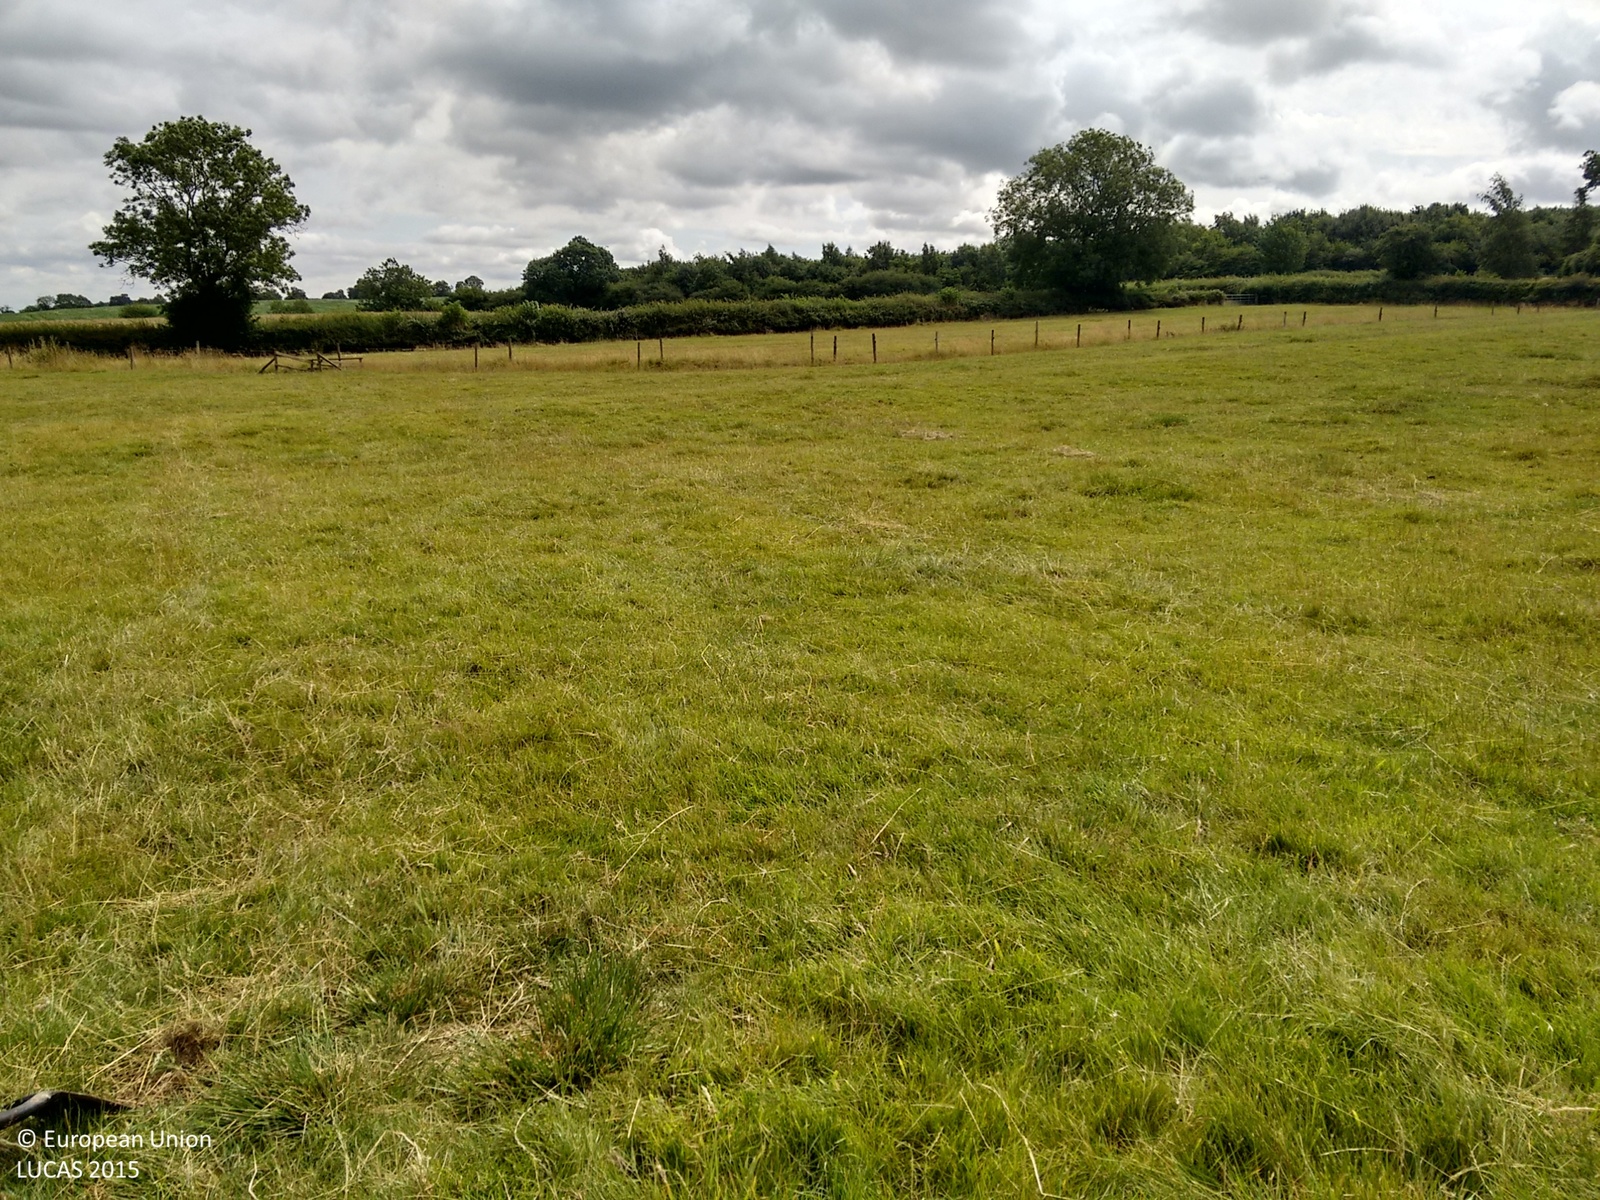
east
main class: Grassland
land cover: Grassland without tree/shrub cover
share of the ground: > 75 %
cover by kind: herbaceous plants 100 %
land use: Agriculture (excluding fallow land and kitchen gardens)
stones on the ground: < 10 %
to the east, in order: Grassland without tree/shrub cover; Fences; Ditches and canals; Fences; Grassland without tree/shrub cover; Fences; Managed hedges; Grassland without tree/shrub cover; Broadleaved woodland
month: July
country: GB
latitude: 52.6367
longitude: -0.6943
